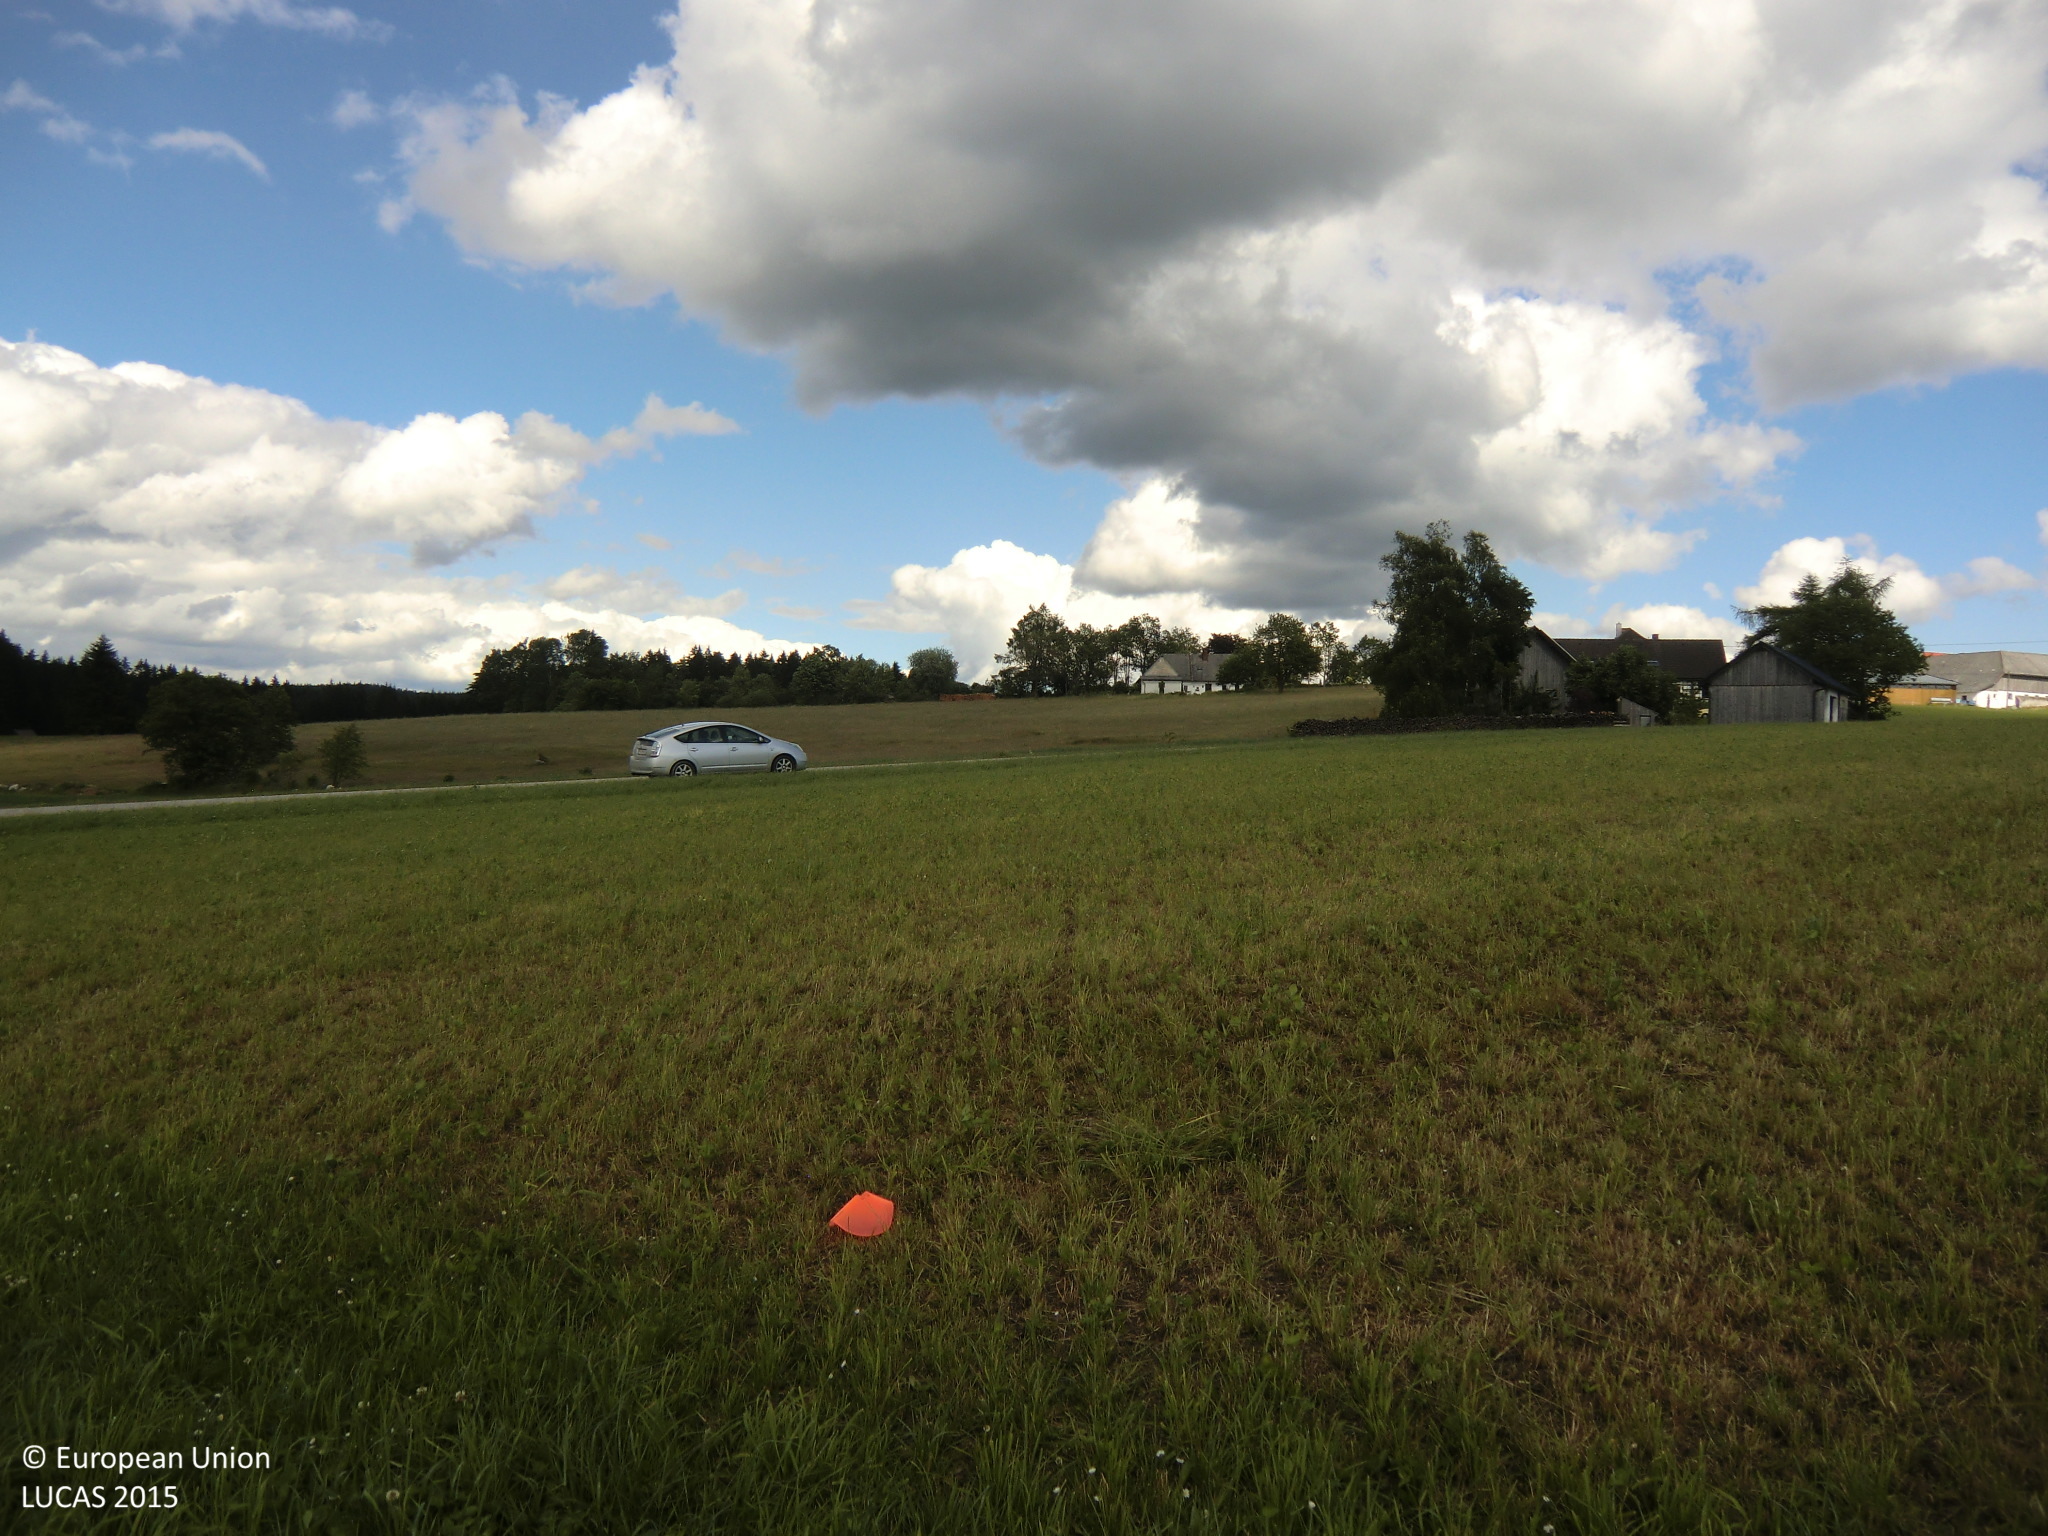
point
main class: Cropland
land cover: Temporary grasslands
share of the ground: 50 - 75 %
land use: Agriculture (excluding fallow land and kitchen gardens)
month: June
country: AT
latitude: 48.5367
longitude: 14.7278
